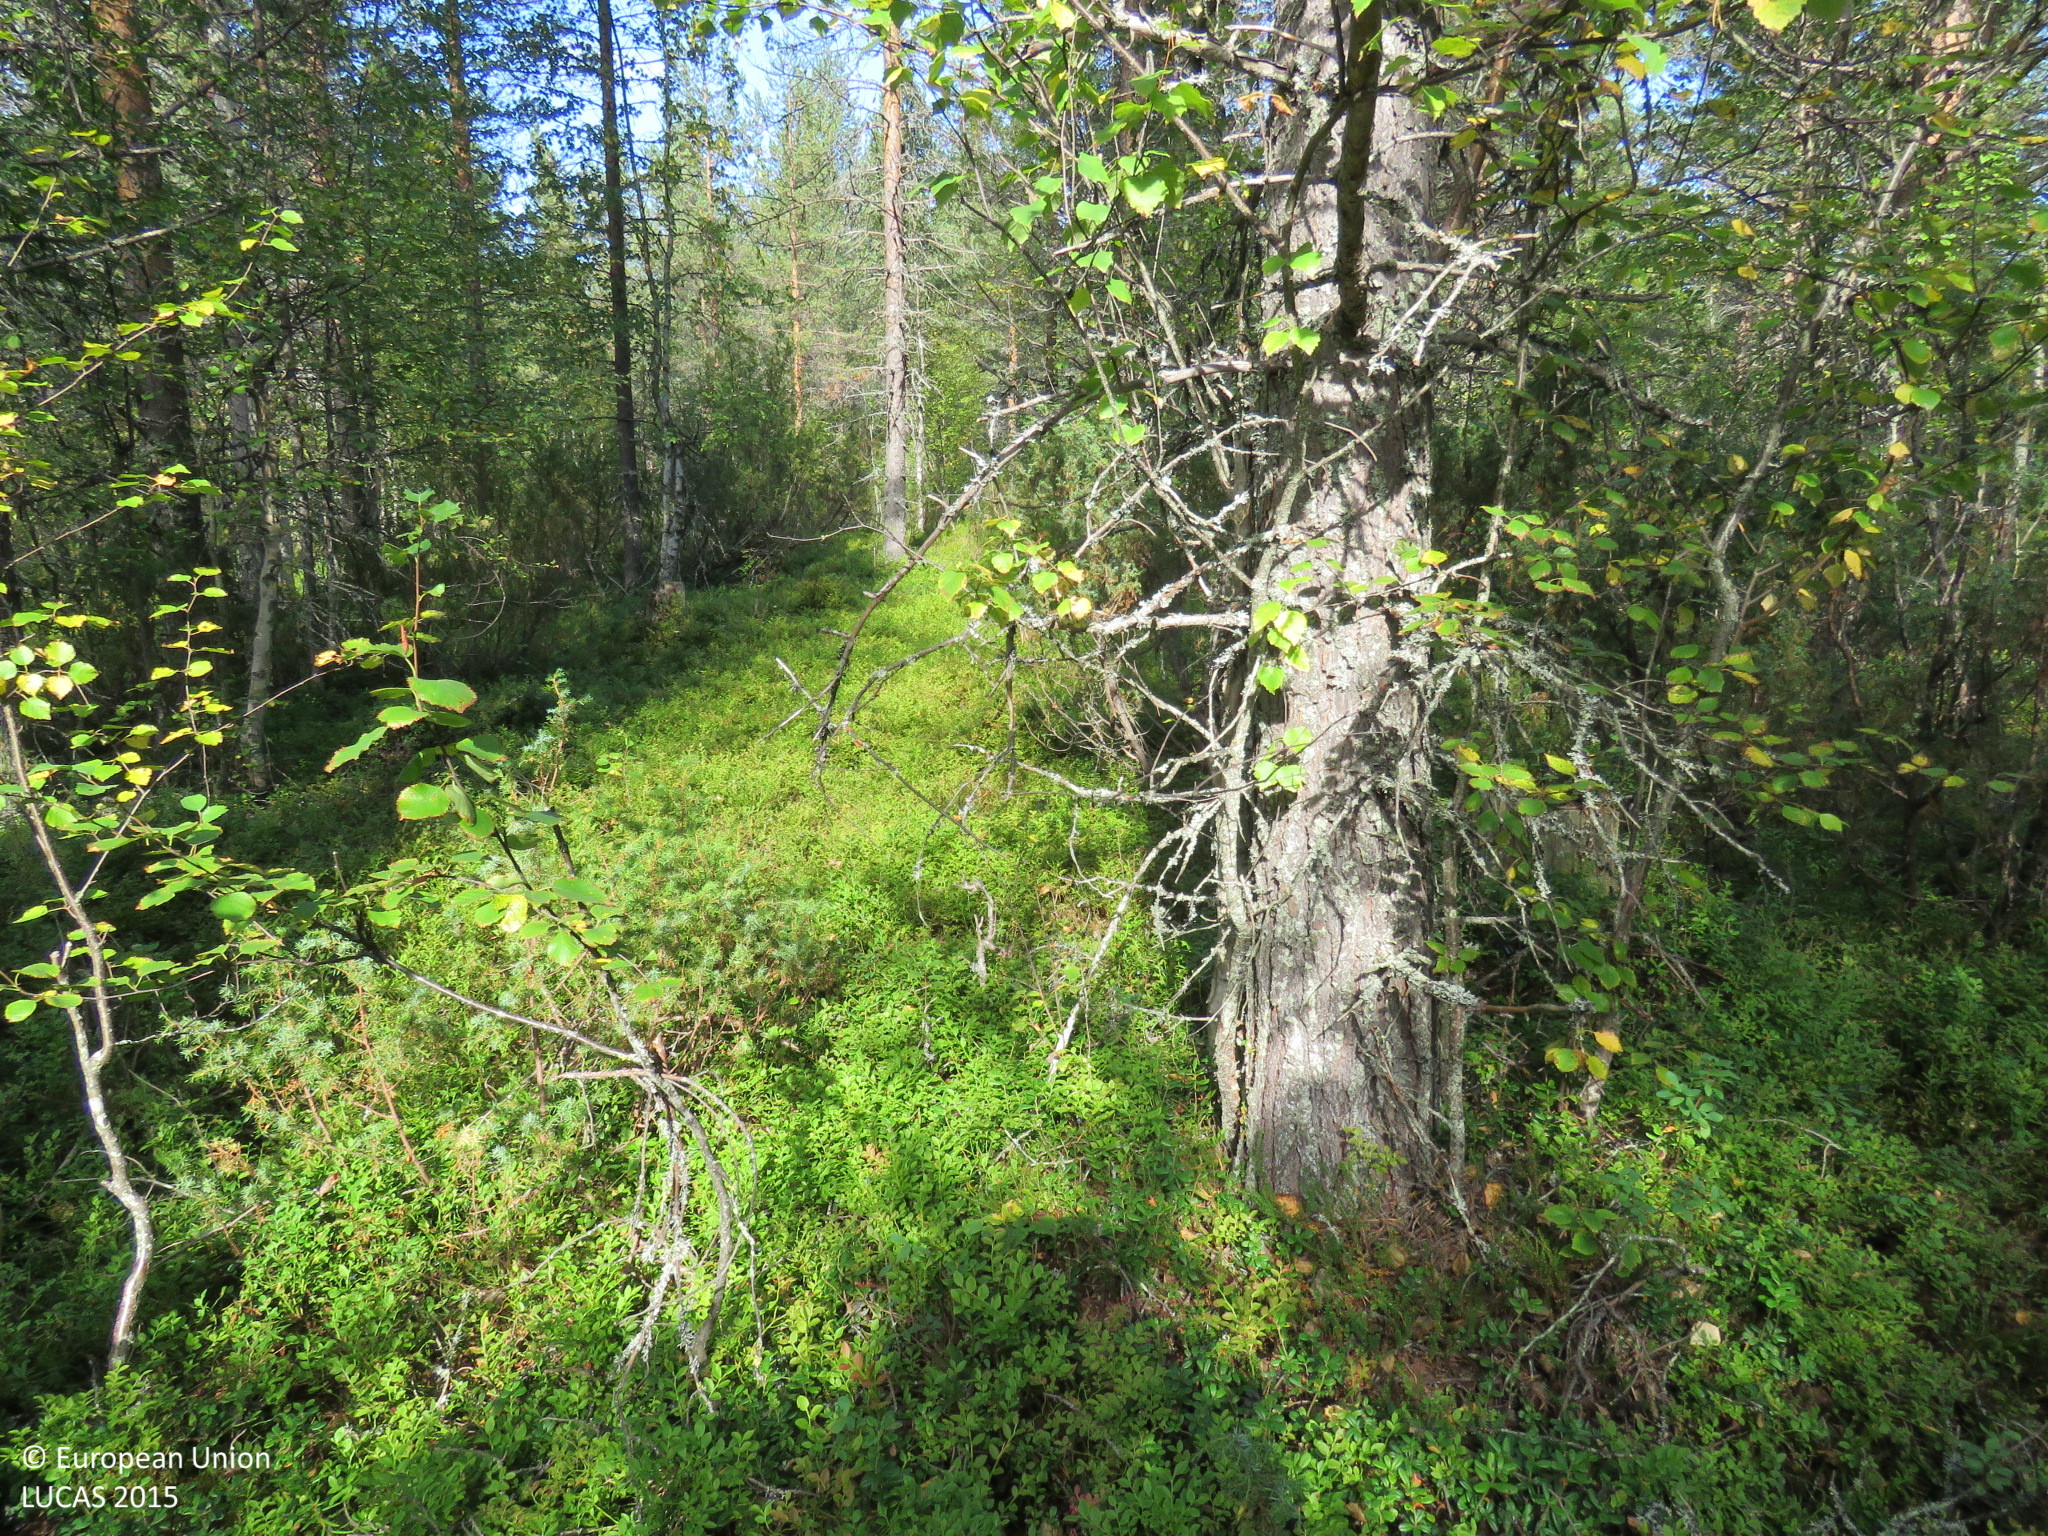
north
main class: Woodland
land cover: Other mixed woodland
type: boreal forest
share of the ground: > 75 %
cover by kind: coniferous forest trees 50 %, broadleaved forest trees 25 %, shrubs 20 %, lichens and mosses 5 %
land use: Forestry
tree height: > 5 m
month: September
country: FI
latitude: 65.4088
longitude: 27.6439
